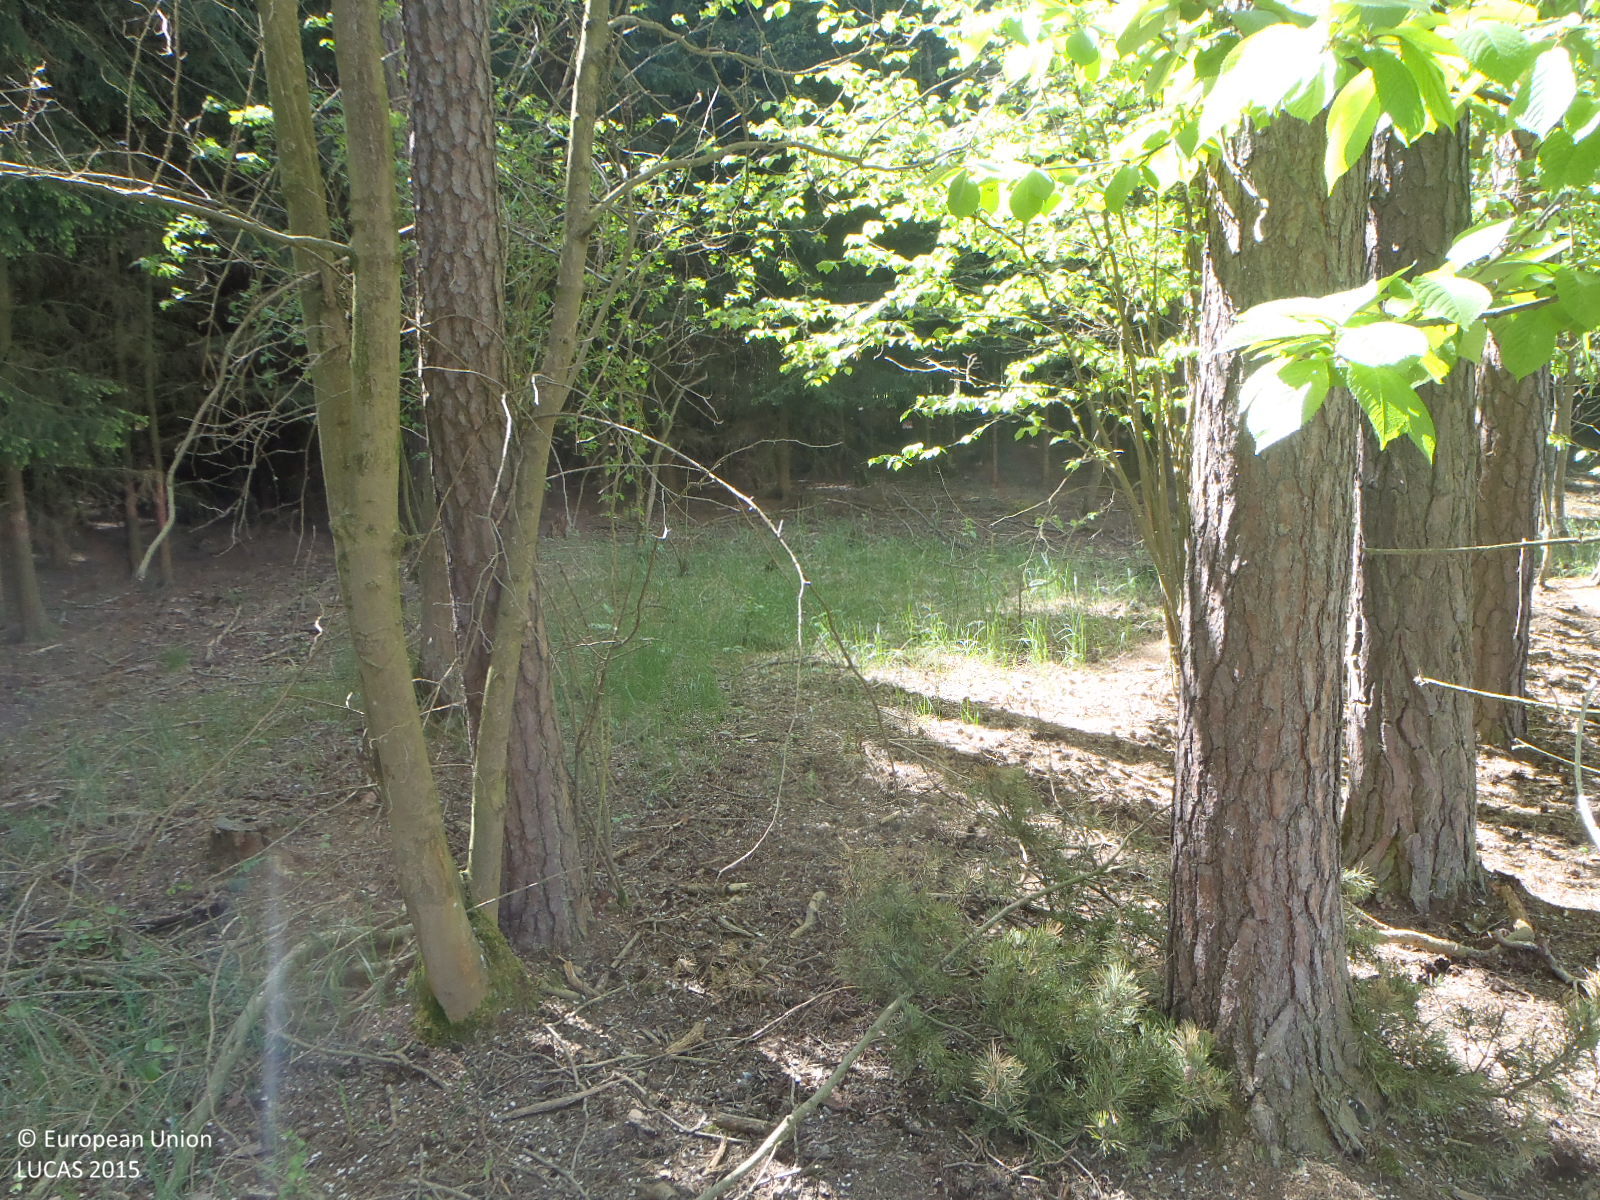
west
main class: Woodland
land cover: Other mixed woodland
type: hemiboreal forest and nemoral coniferous forest and mixed broadleaved-coniferous forest
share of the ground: > 75 %
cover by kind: coniferous forest trees 65 %, broadleaved forest trees 25 %, herbaceous plants 5 %, unconsolidated bare surface 5 %
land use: Forestry
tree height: > 5 m
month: May
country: CZ
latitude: 49.1488
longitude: 15.5286
